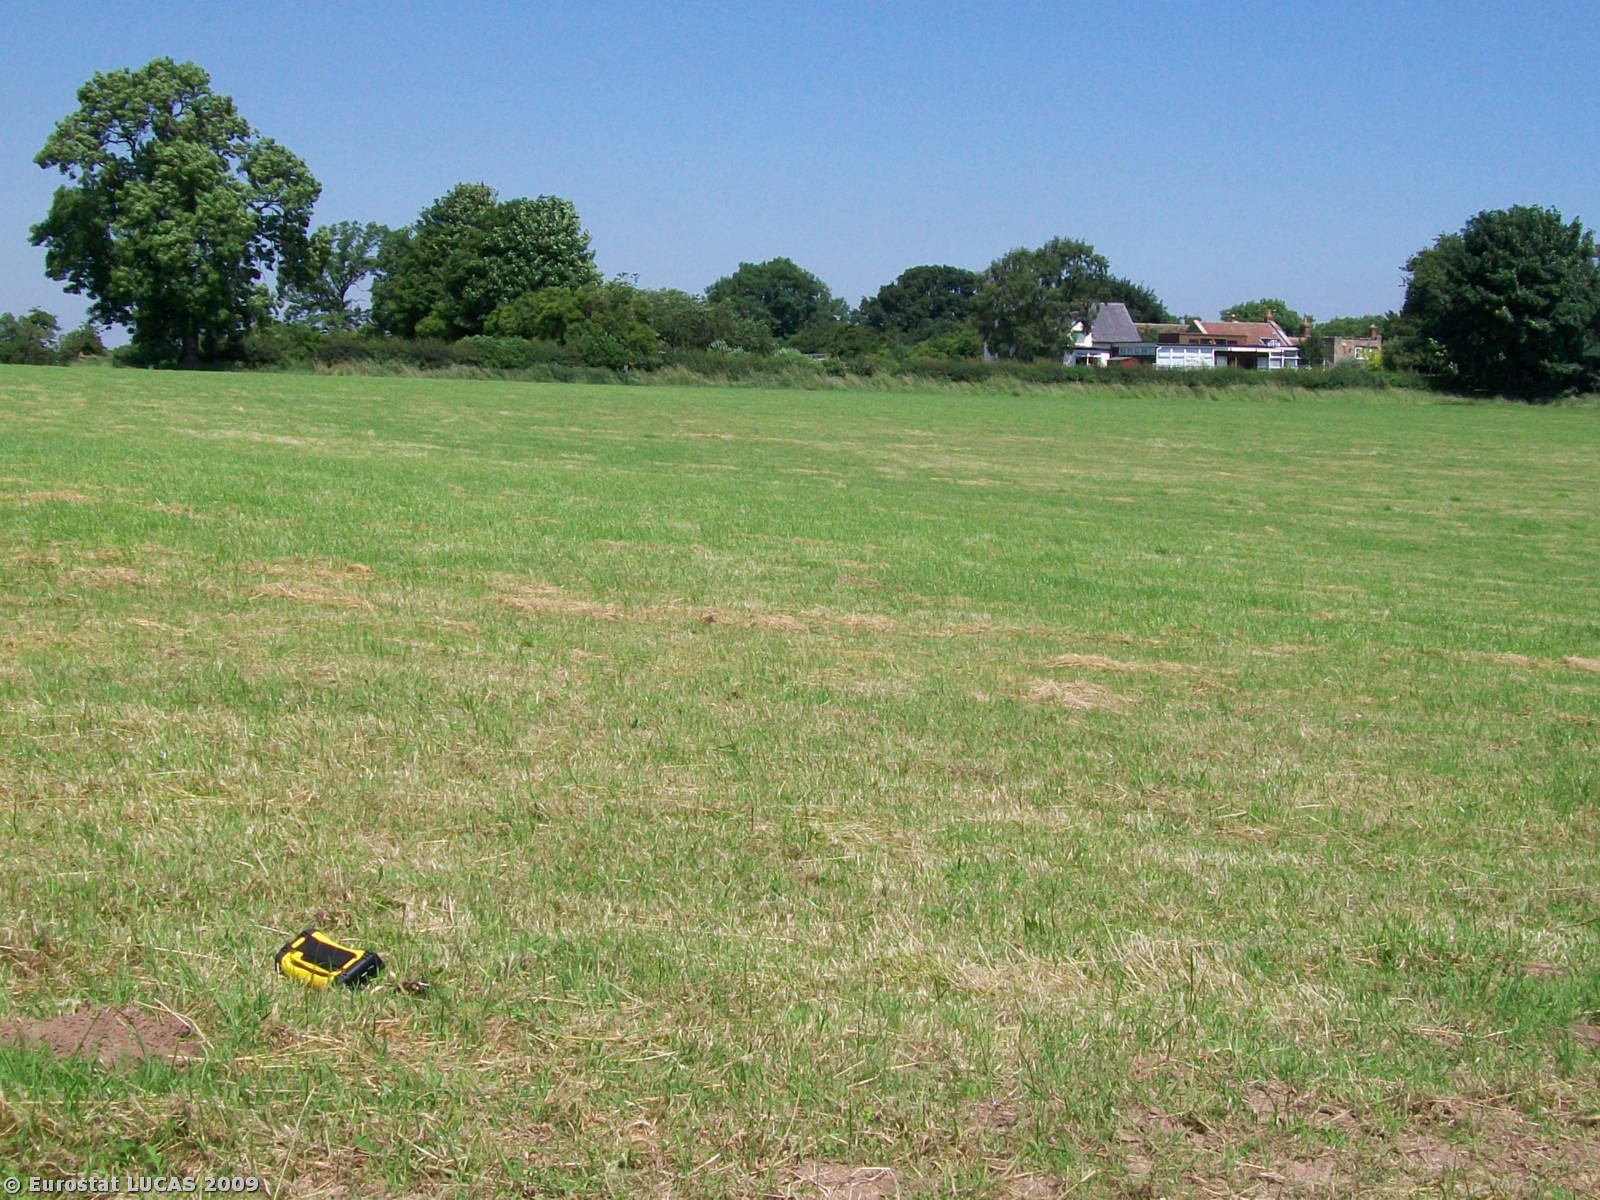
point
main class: Grassland
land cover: Grassland without tree/shrub cover
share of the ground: < 10 %
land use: Agriculture (excluding fallow land and kitchen gardens)
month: July
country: GB
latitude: 53.9281
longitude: -1.4557
